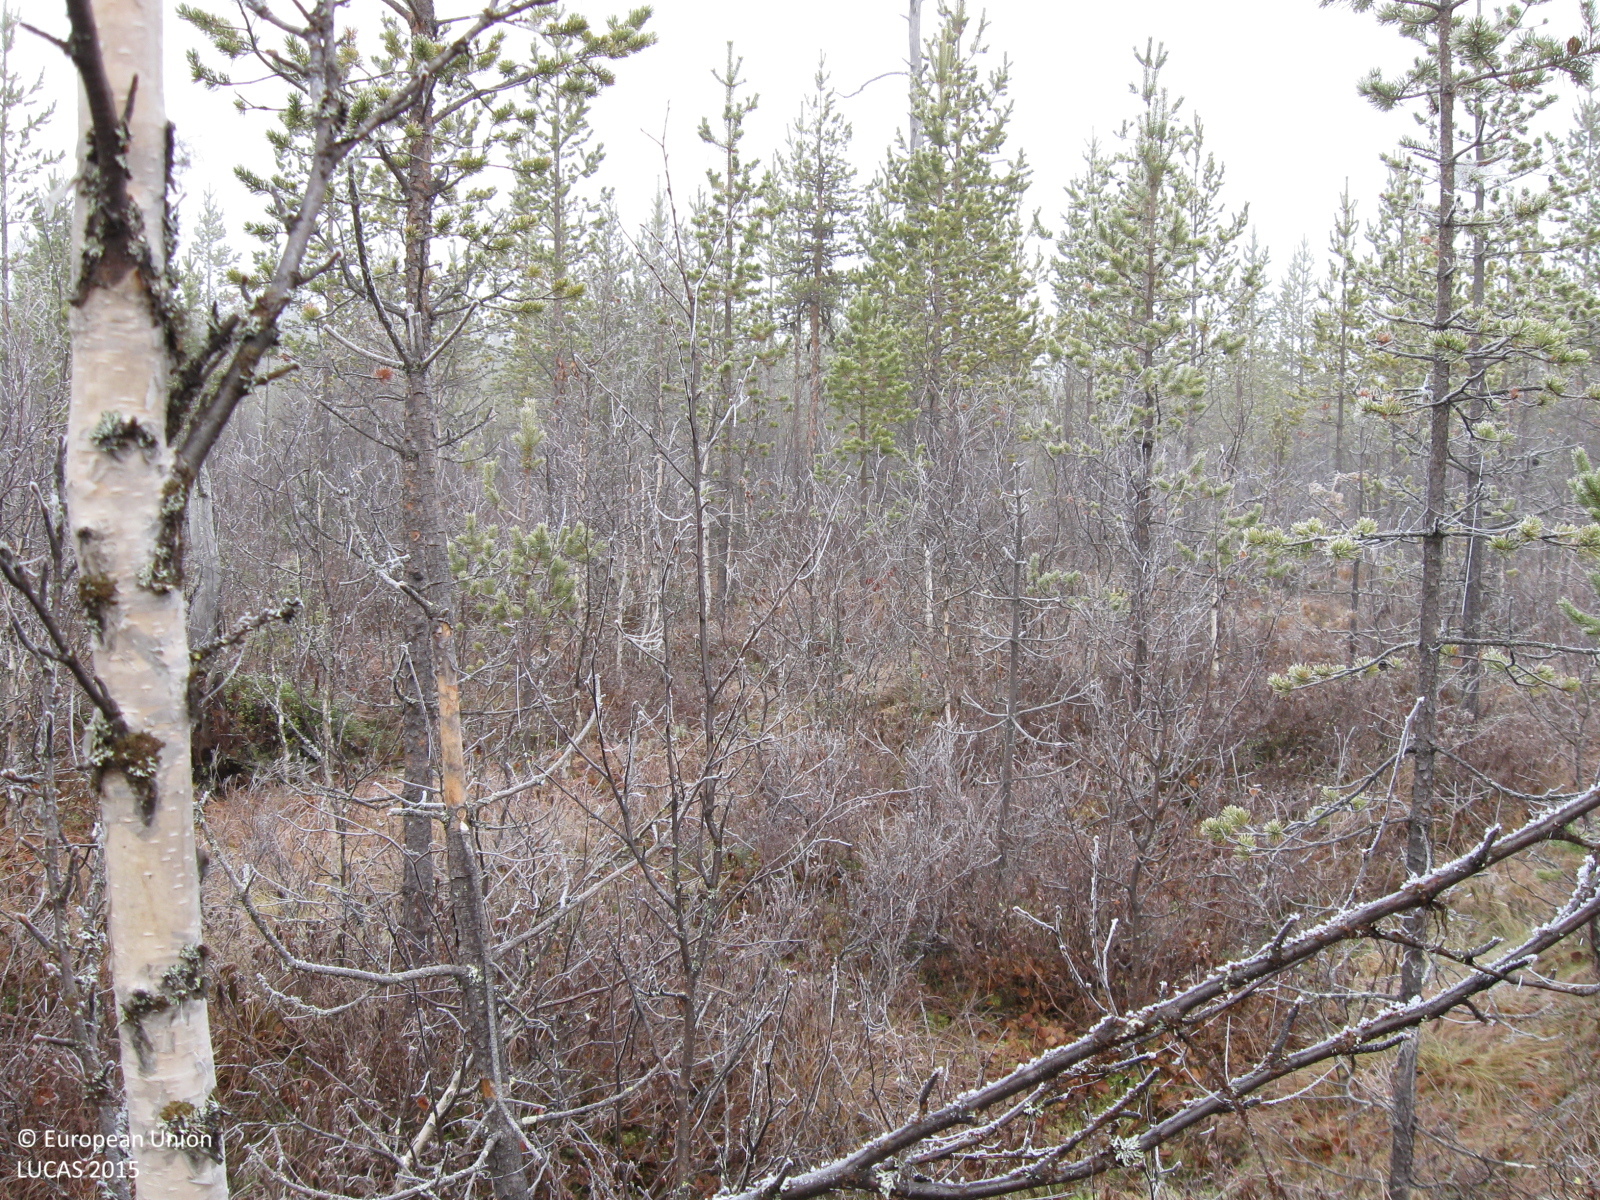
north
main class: Woodland
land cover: Pine dominated mixed woodland
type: mire and swamp forests
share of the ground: 50 - 75 %
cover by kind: coniferous forest trees 35 %, shrubs 30 %, broadleaved forest trees 15 %, herbaceous plants 10 %, lichens and mosses 10 %
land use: Forestry
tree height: < 5 m
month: October
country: SE
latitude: 66.3605
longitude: 21.7442
